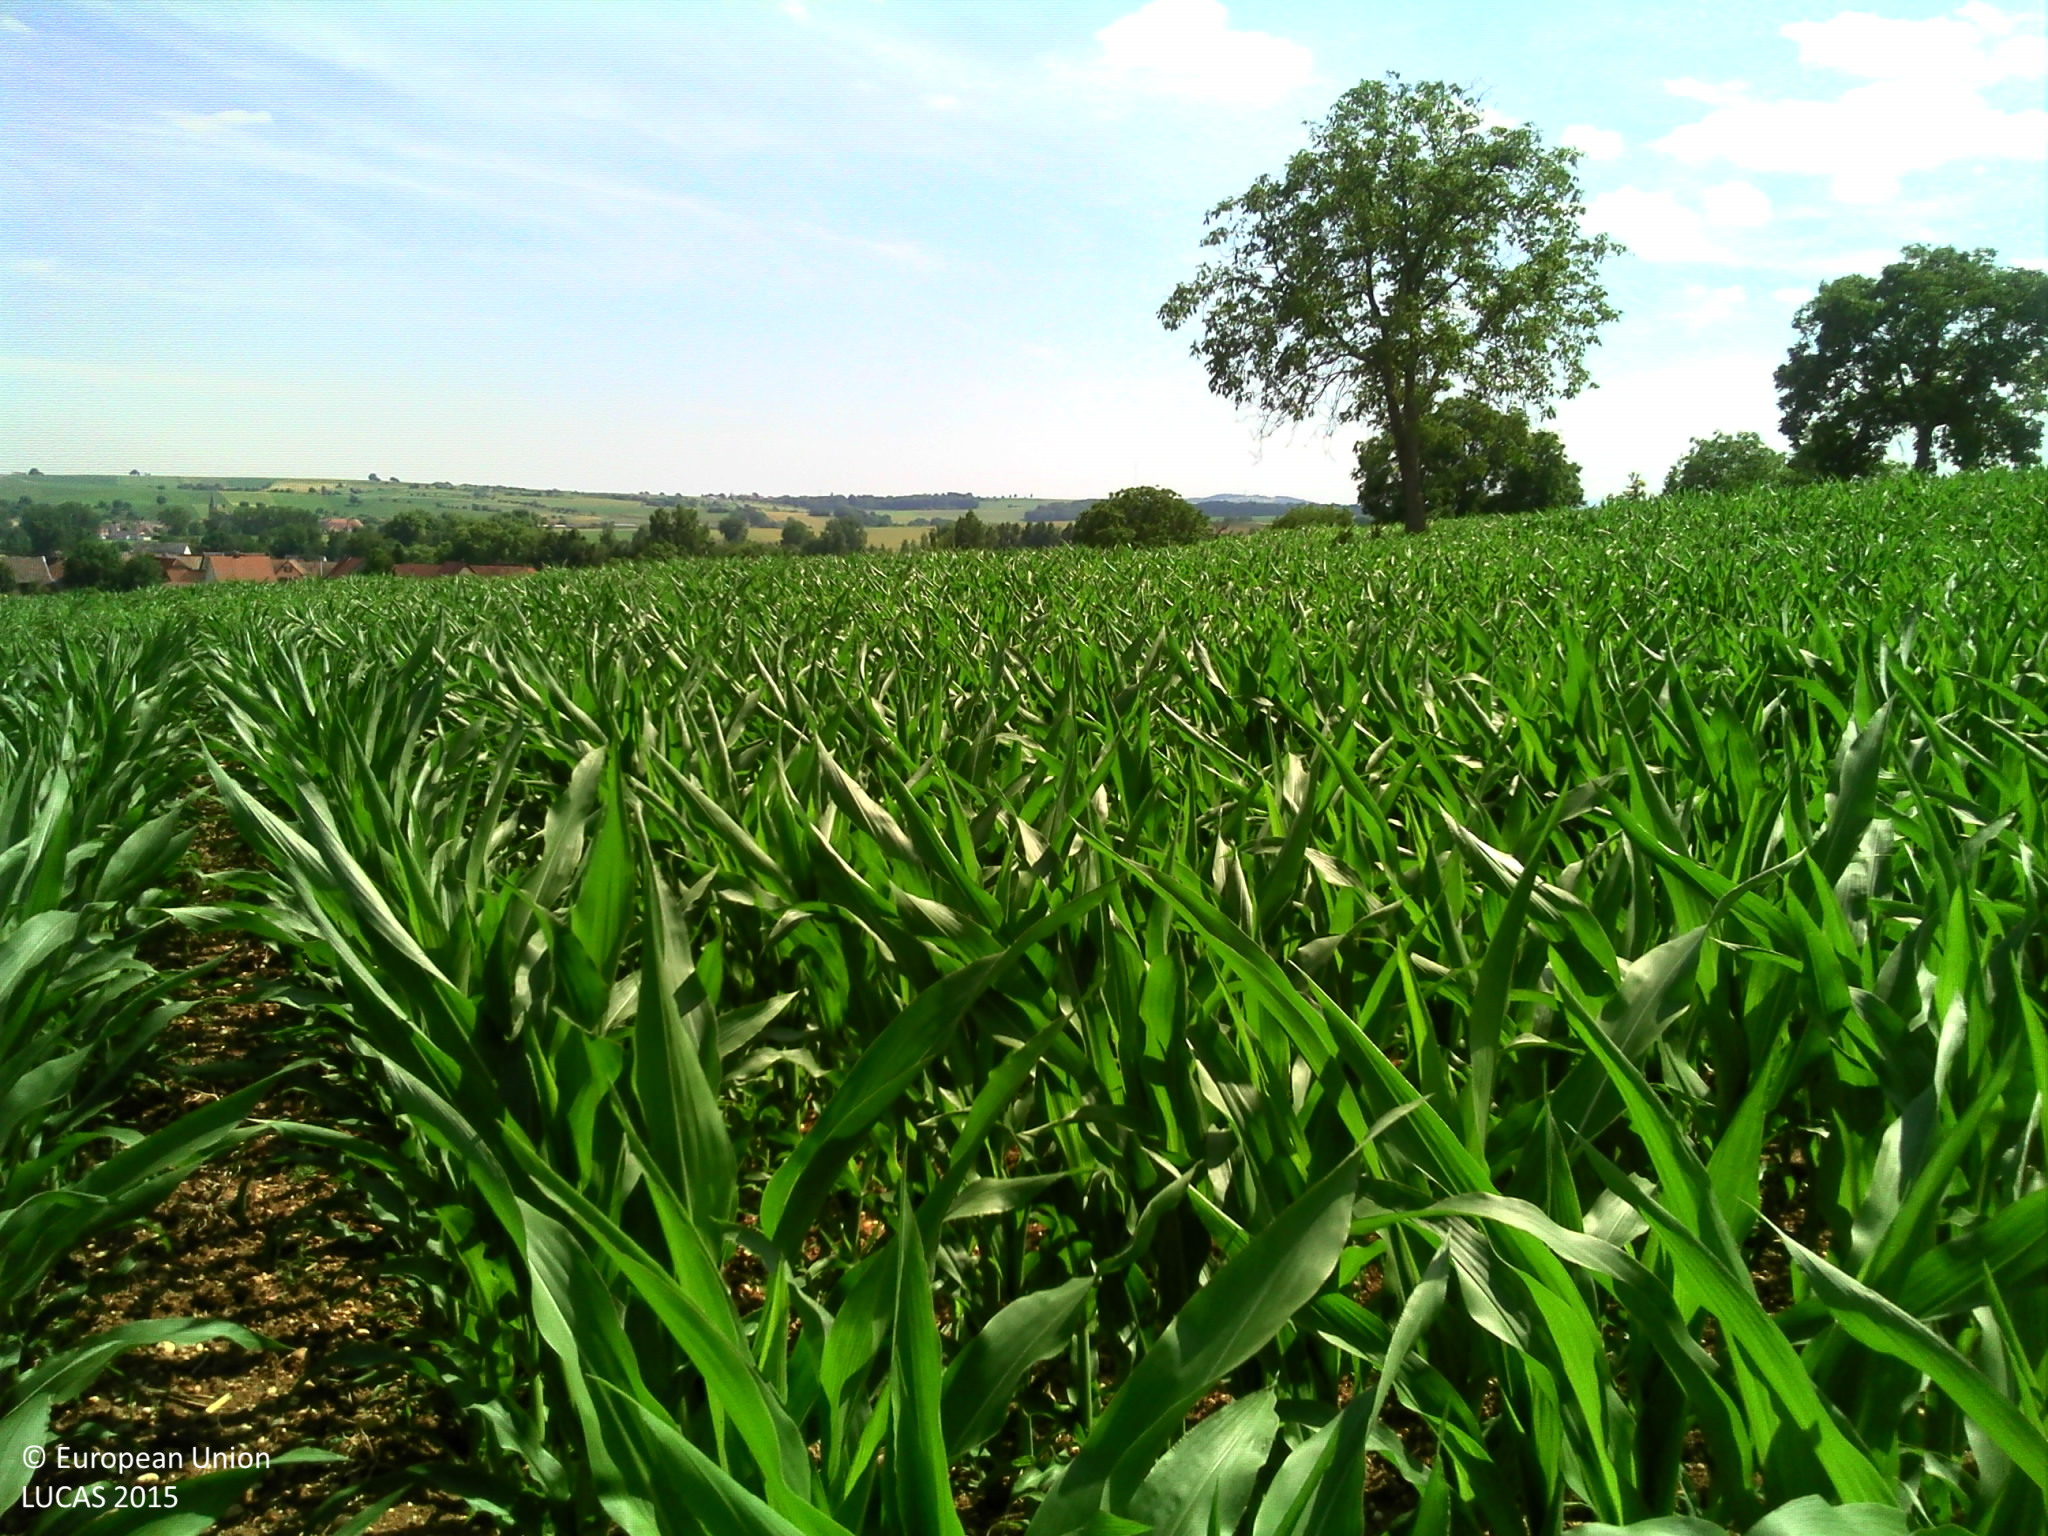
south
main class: Cropland
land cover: Maize
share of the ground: 50 - 75 %
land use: Agriculture (excluding fallow land and kitchen gardens)
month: June
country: FR
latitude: 48.7535
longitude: 7.5116
